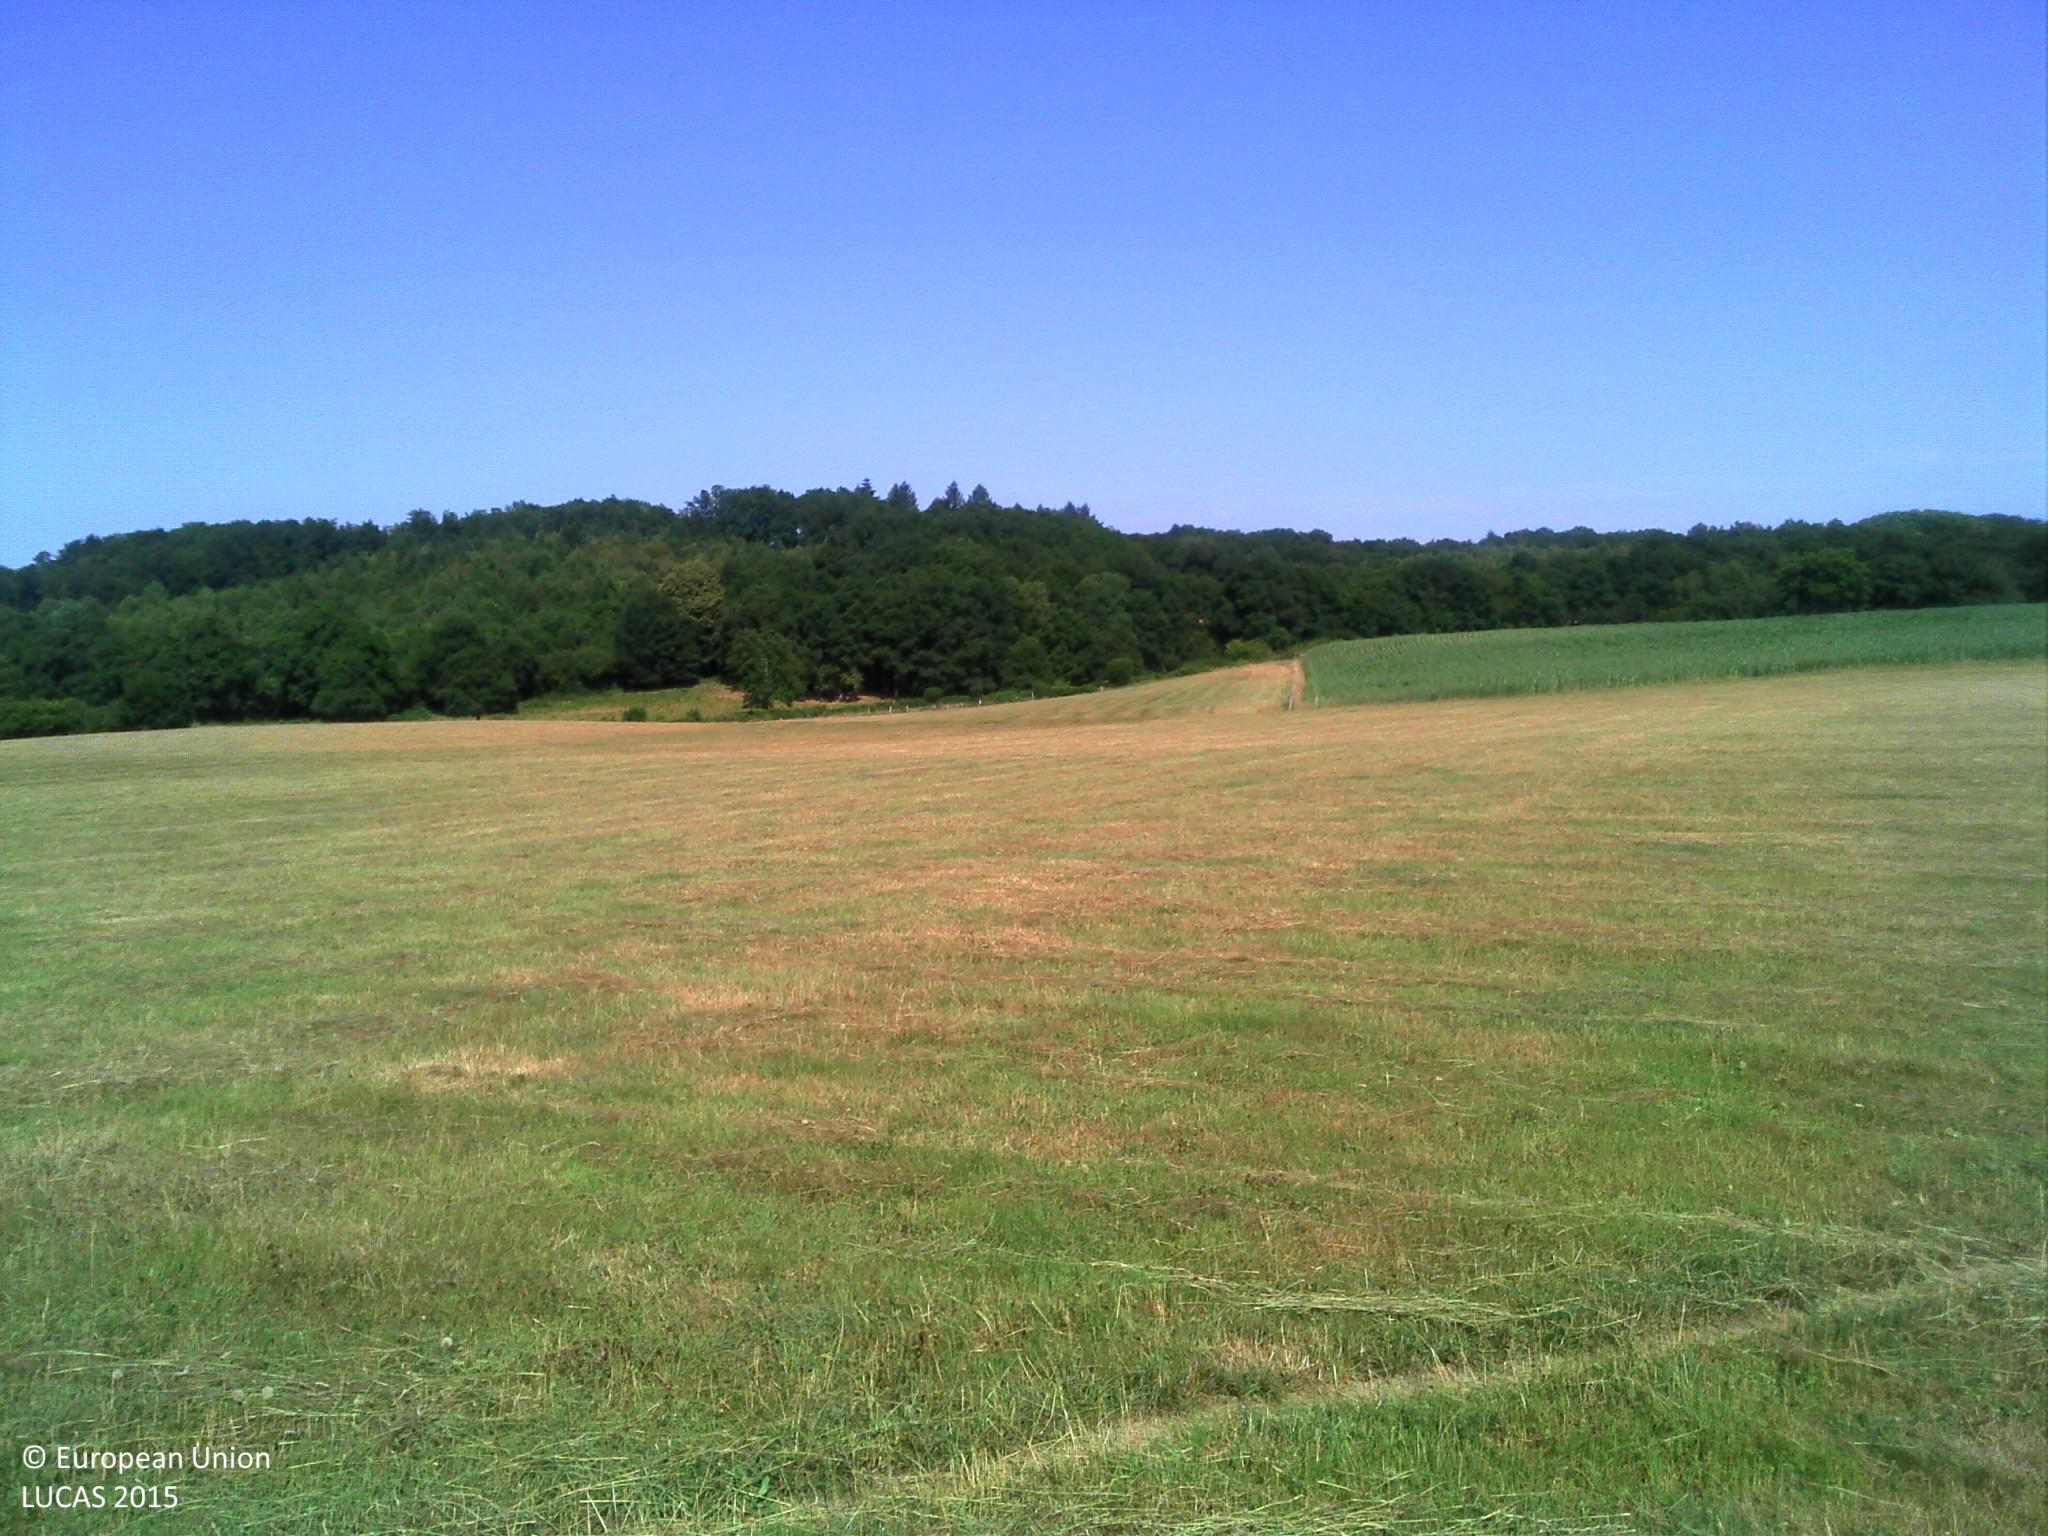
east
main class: Grassland
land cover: Grassland without tree/shrub cover
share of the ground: > 75 %
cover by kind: herbaceous plants 100 %
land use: Agriculture (excluding fallow land and kitchen gardens)
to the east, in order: Grassland without tree/shrub cover
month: July
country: FR
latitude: 46.0271
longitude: 1.6858
